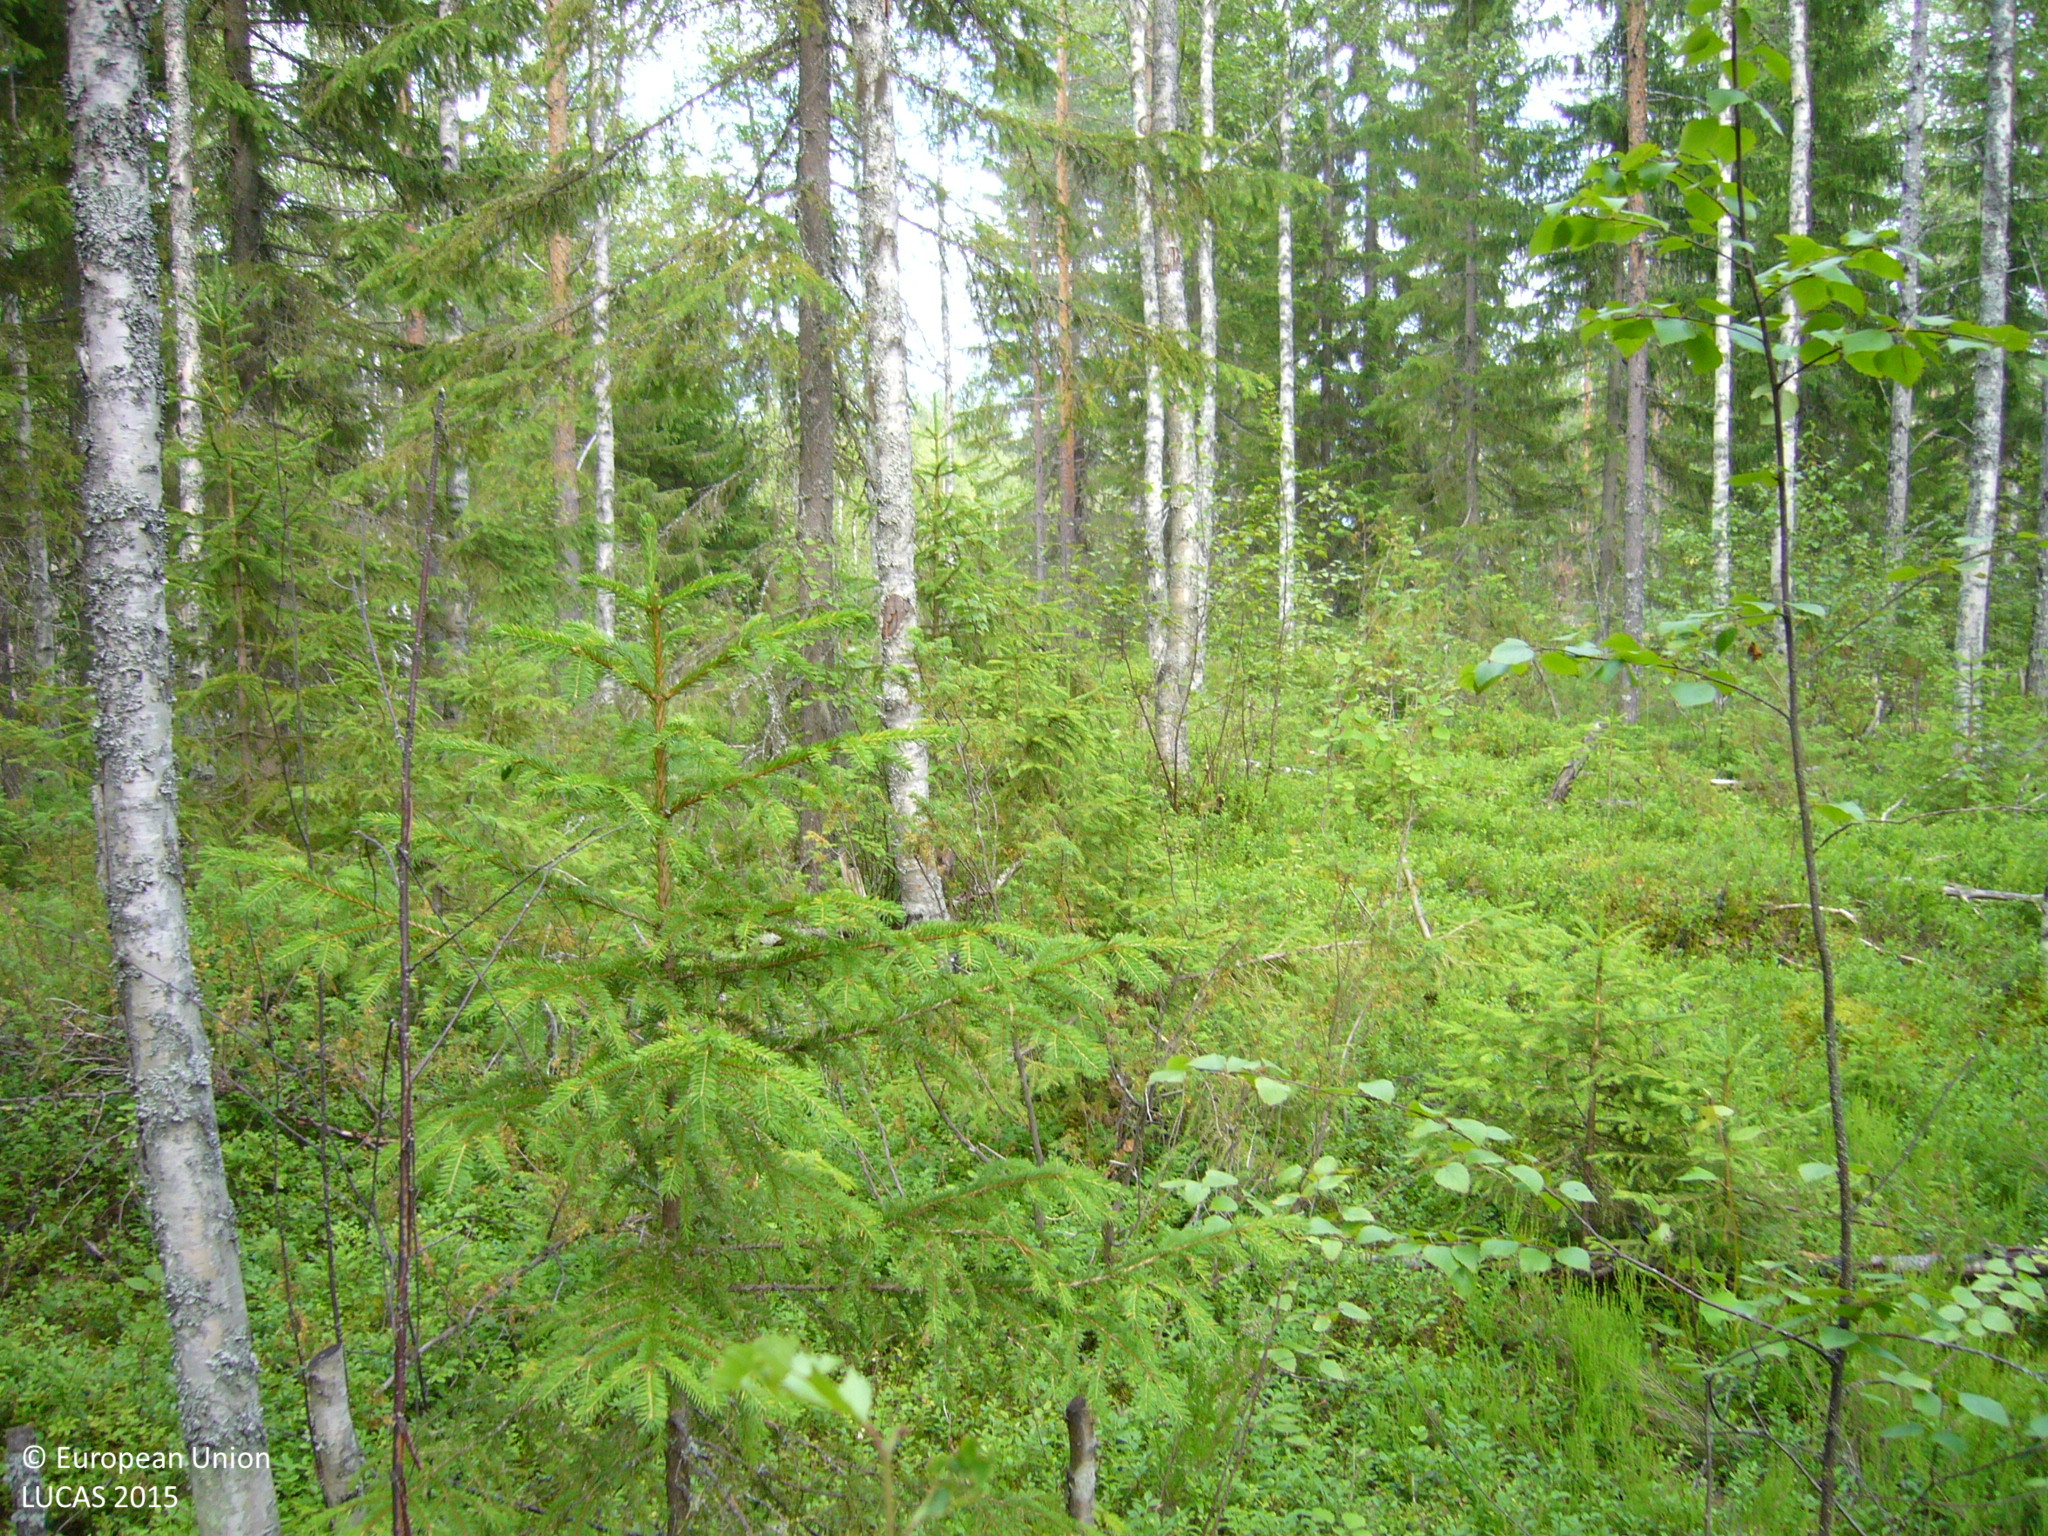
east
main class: Woodland
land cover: Pine dominated mixed woodland
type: boreal forest
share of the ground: > 75 %
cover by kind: coniferous forest trees 40 %, broadleaved forest trees 35 %, shrubs 25 %
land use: Forestry
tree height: > 5 m
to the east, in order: Pine dominated mixed woodland; Ditches and canals; Paved roads, cycling and walking lanes; Ditches and canals; Spruce dominated mixed woodland; Pine dominated mixed woodland; Ditches and canals; Pine dominated mixed woodland; Spruce dominated mixed woodland
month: July
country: FI
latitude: 63.9640
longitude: 26.7286
